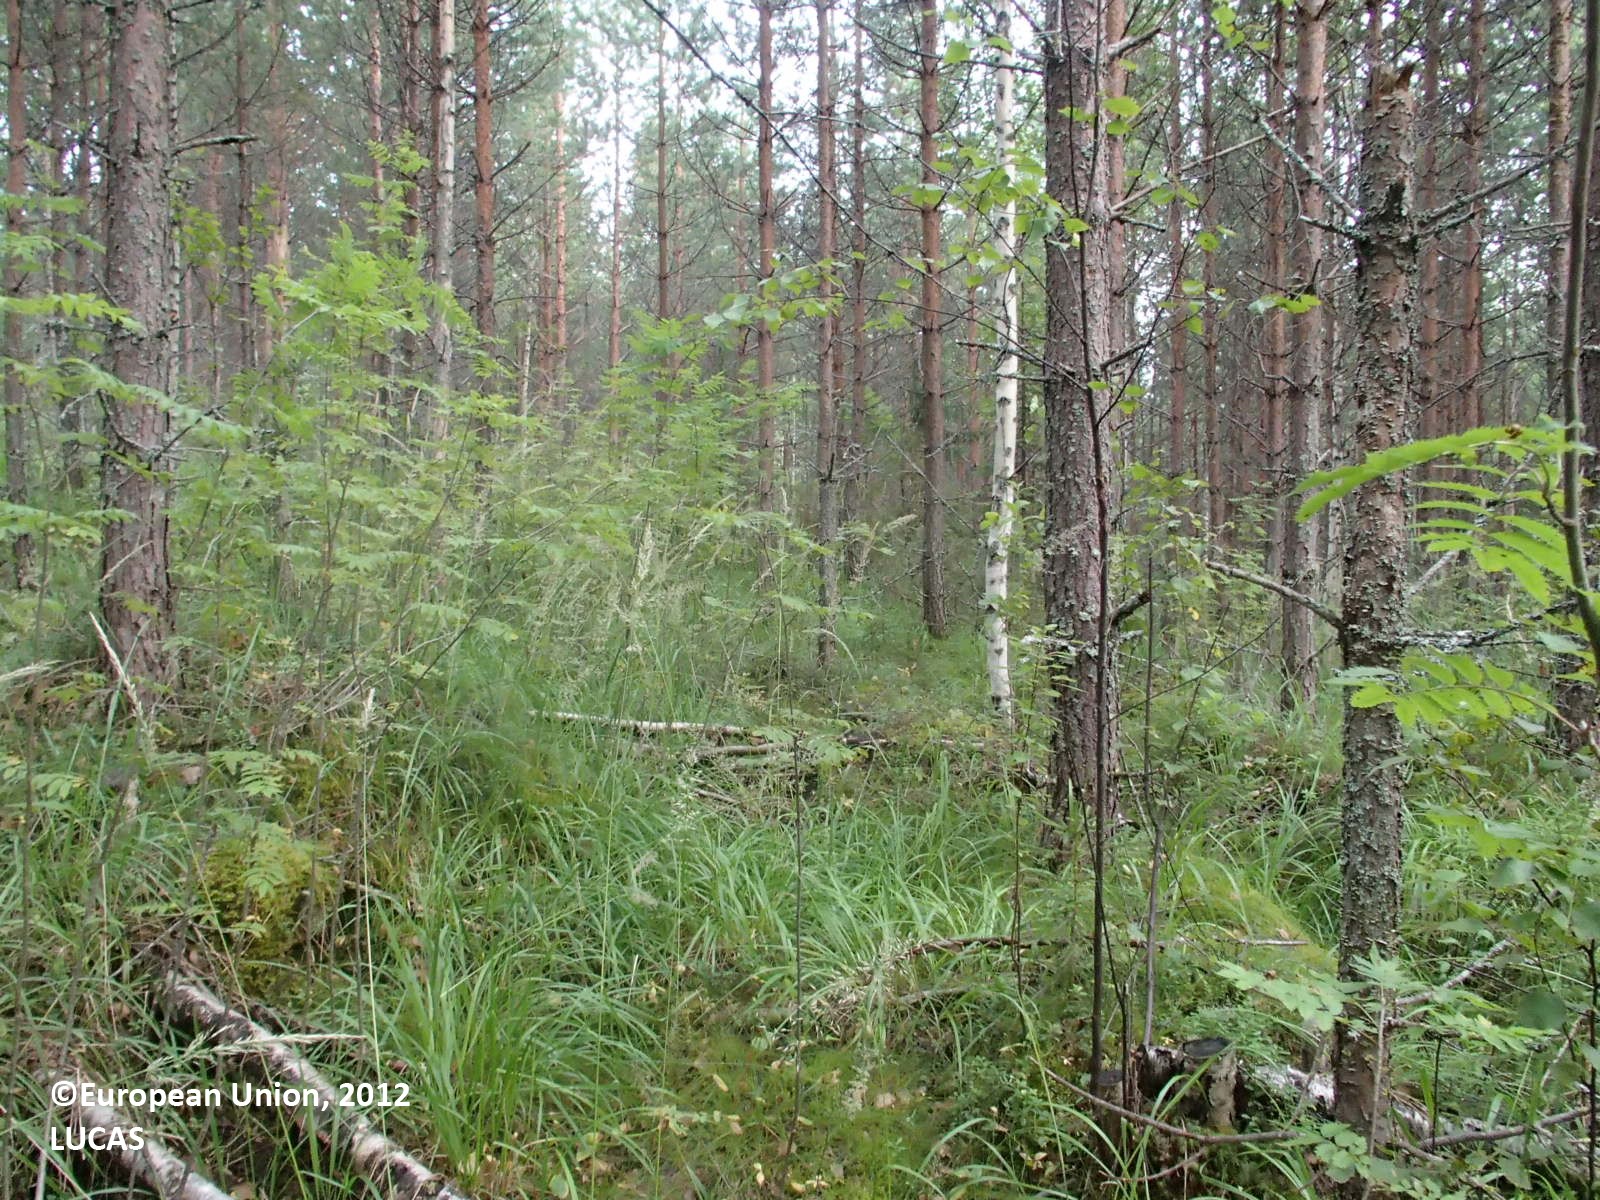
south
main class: Woodland
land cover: Pine dominated mixed woodland
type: boreal forest
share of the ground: > 75 %
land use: Forestry
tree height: > 5 m
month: August
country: FI
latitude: 63.5519
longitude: 28.0641
